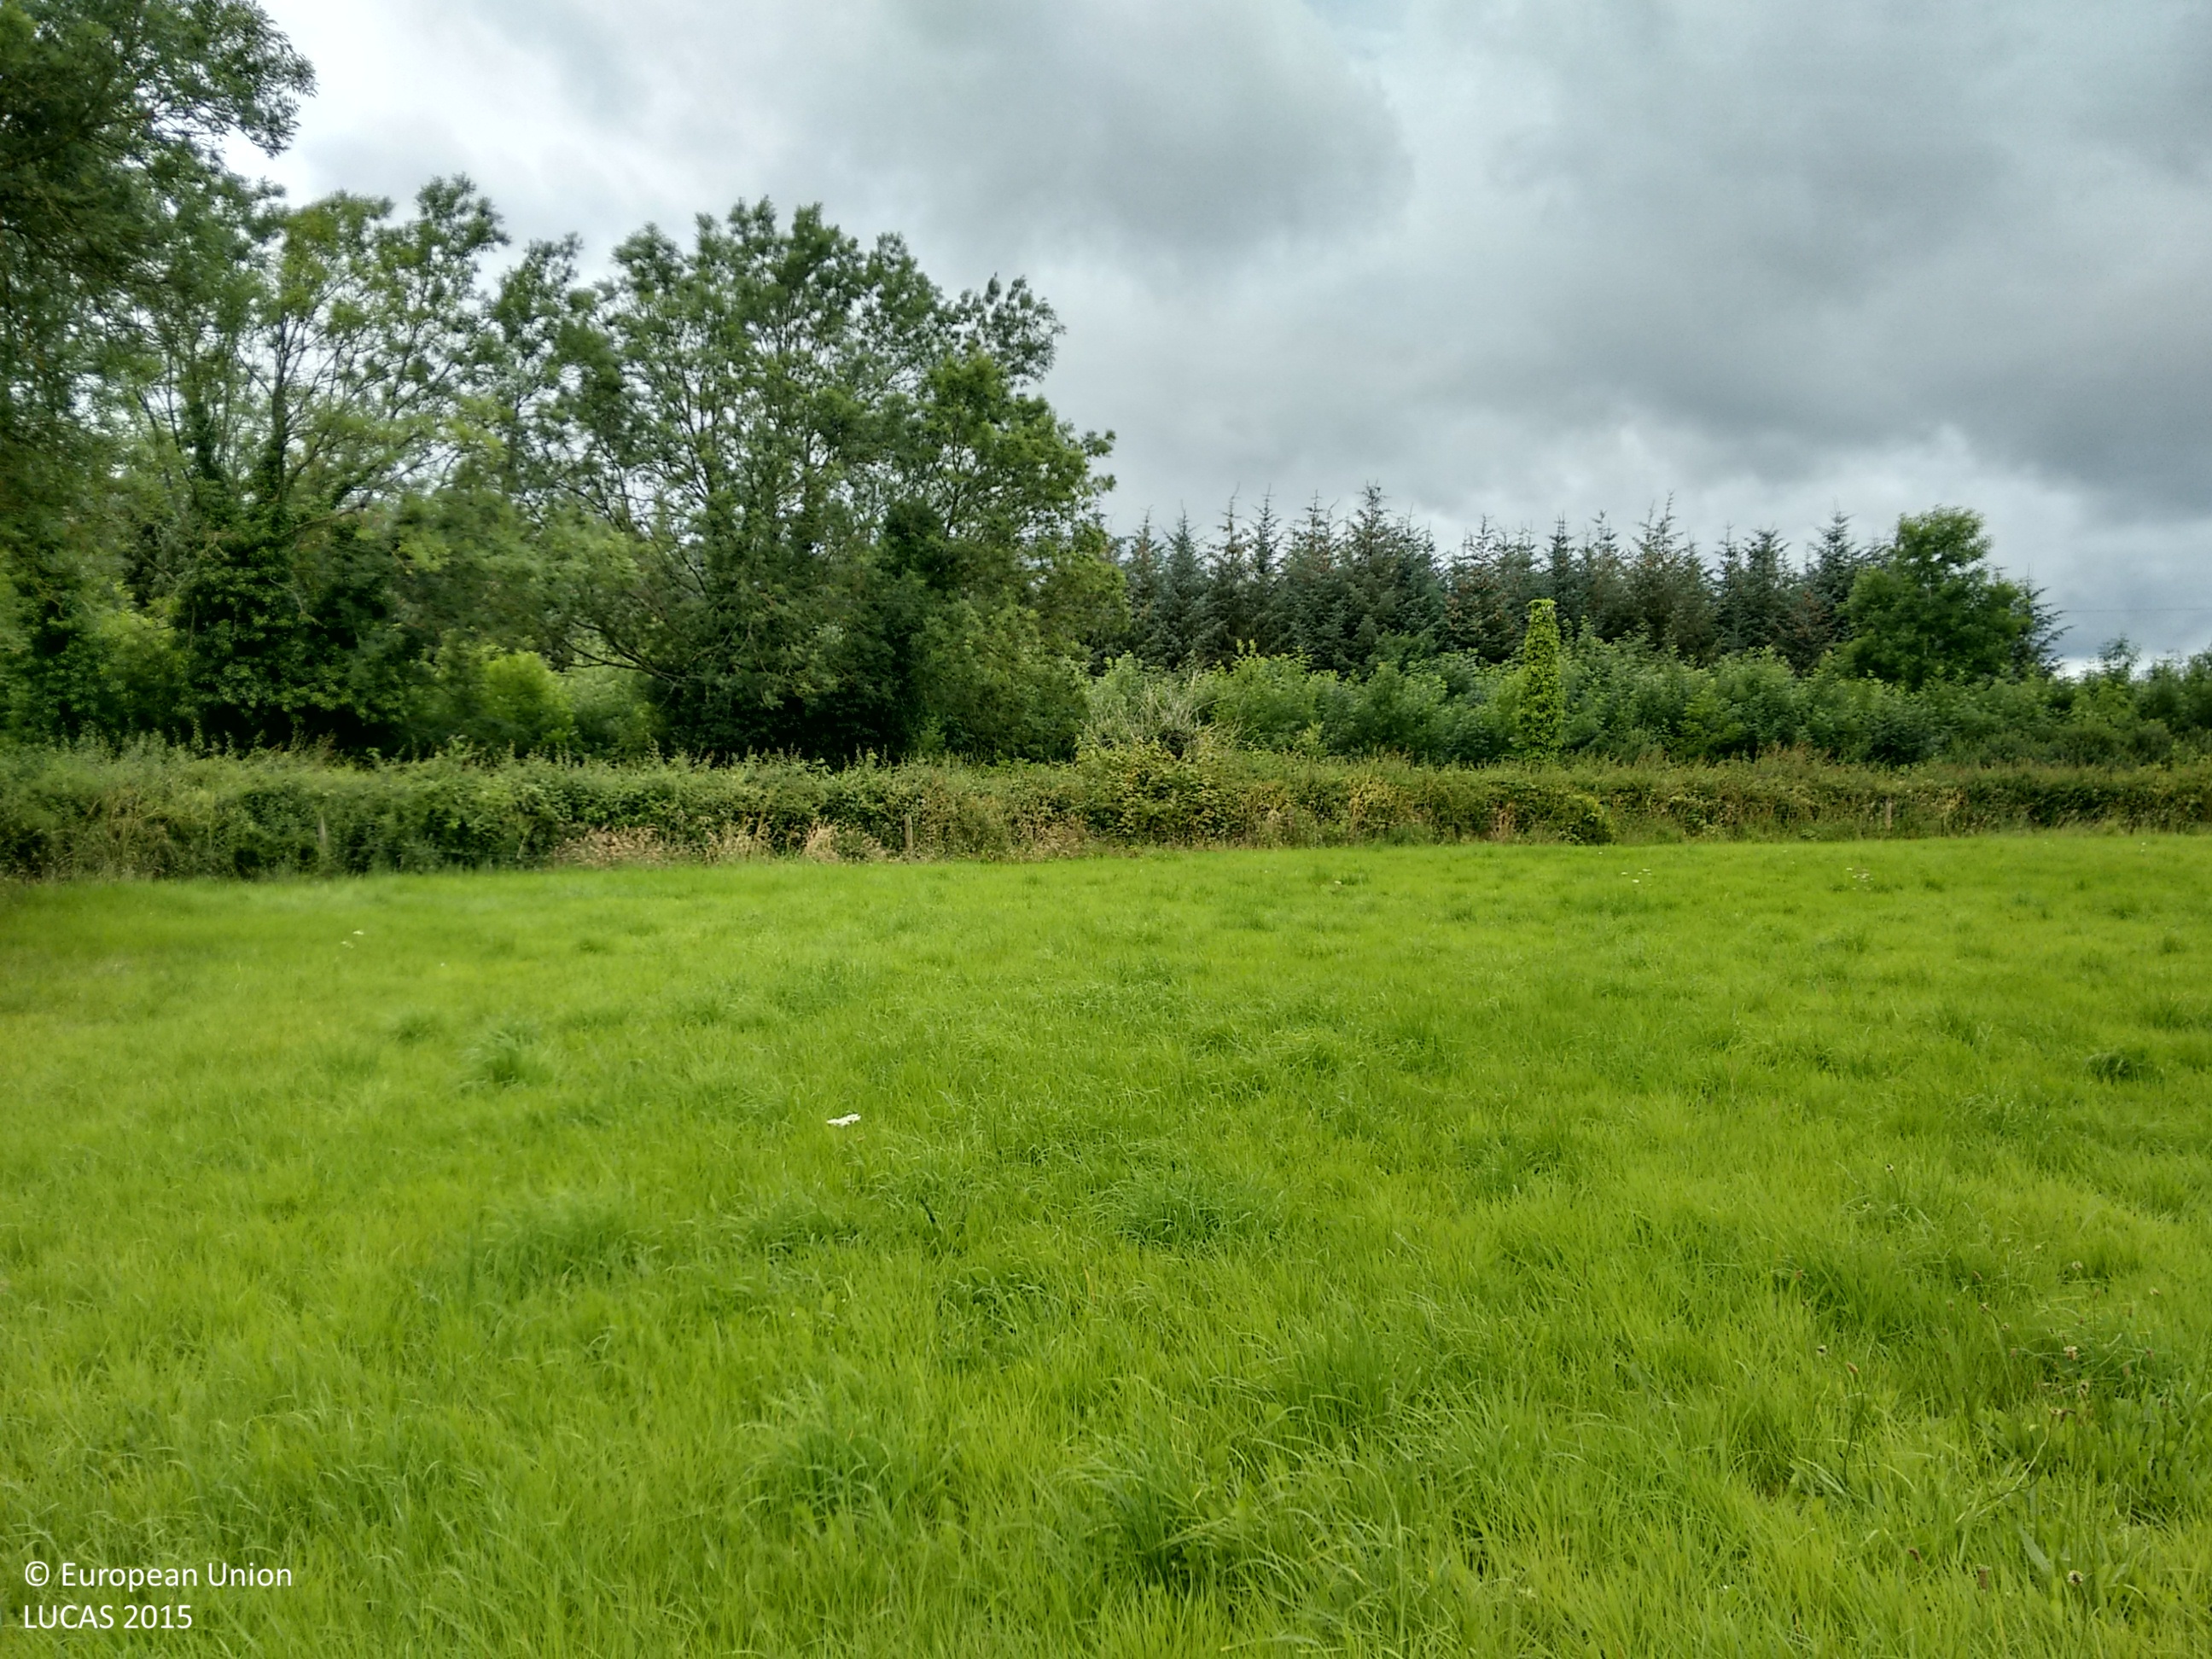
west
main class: Grassland
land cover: Grassland without tree/shrub cover
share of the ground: > 75 %
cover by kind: herbaceous plants 100 %
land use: Agriculture (excluding fallow land and kitchen gardens)
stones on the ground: < 10 %
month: July
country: IE
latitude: 52.5994
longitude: -7.3239
